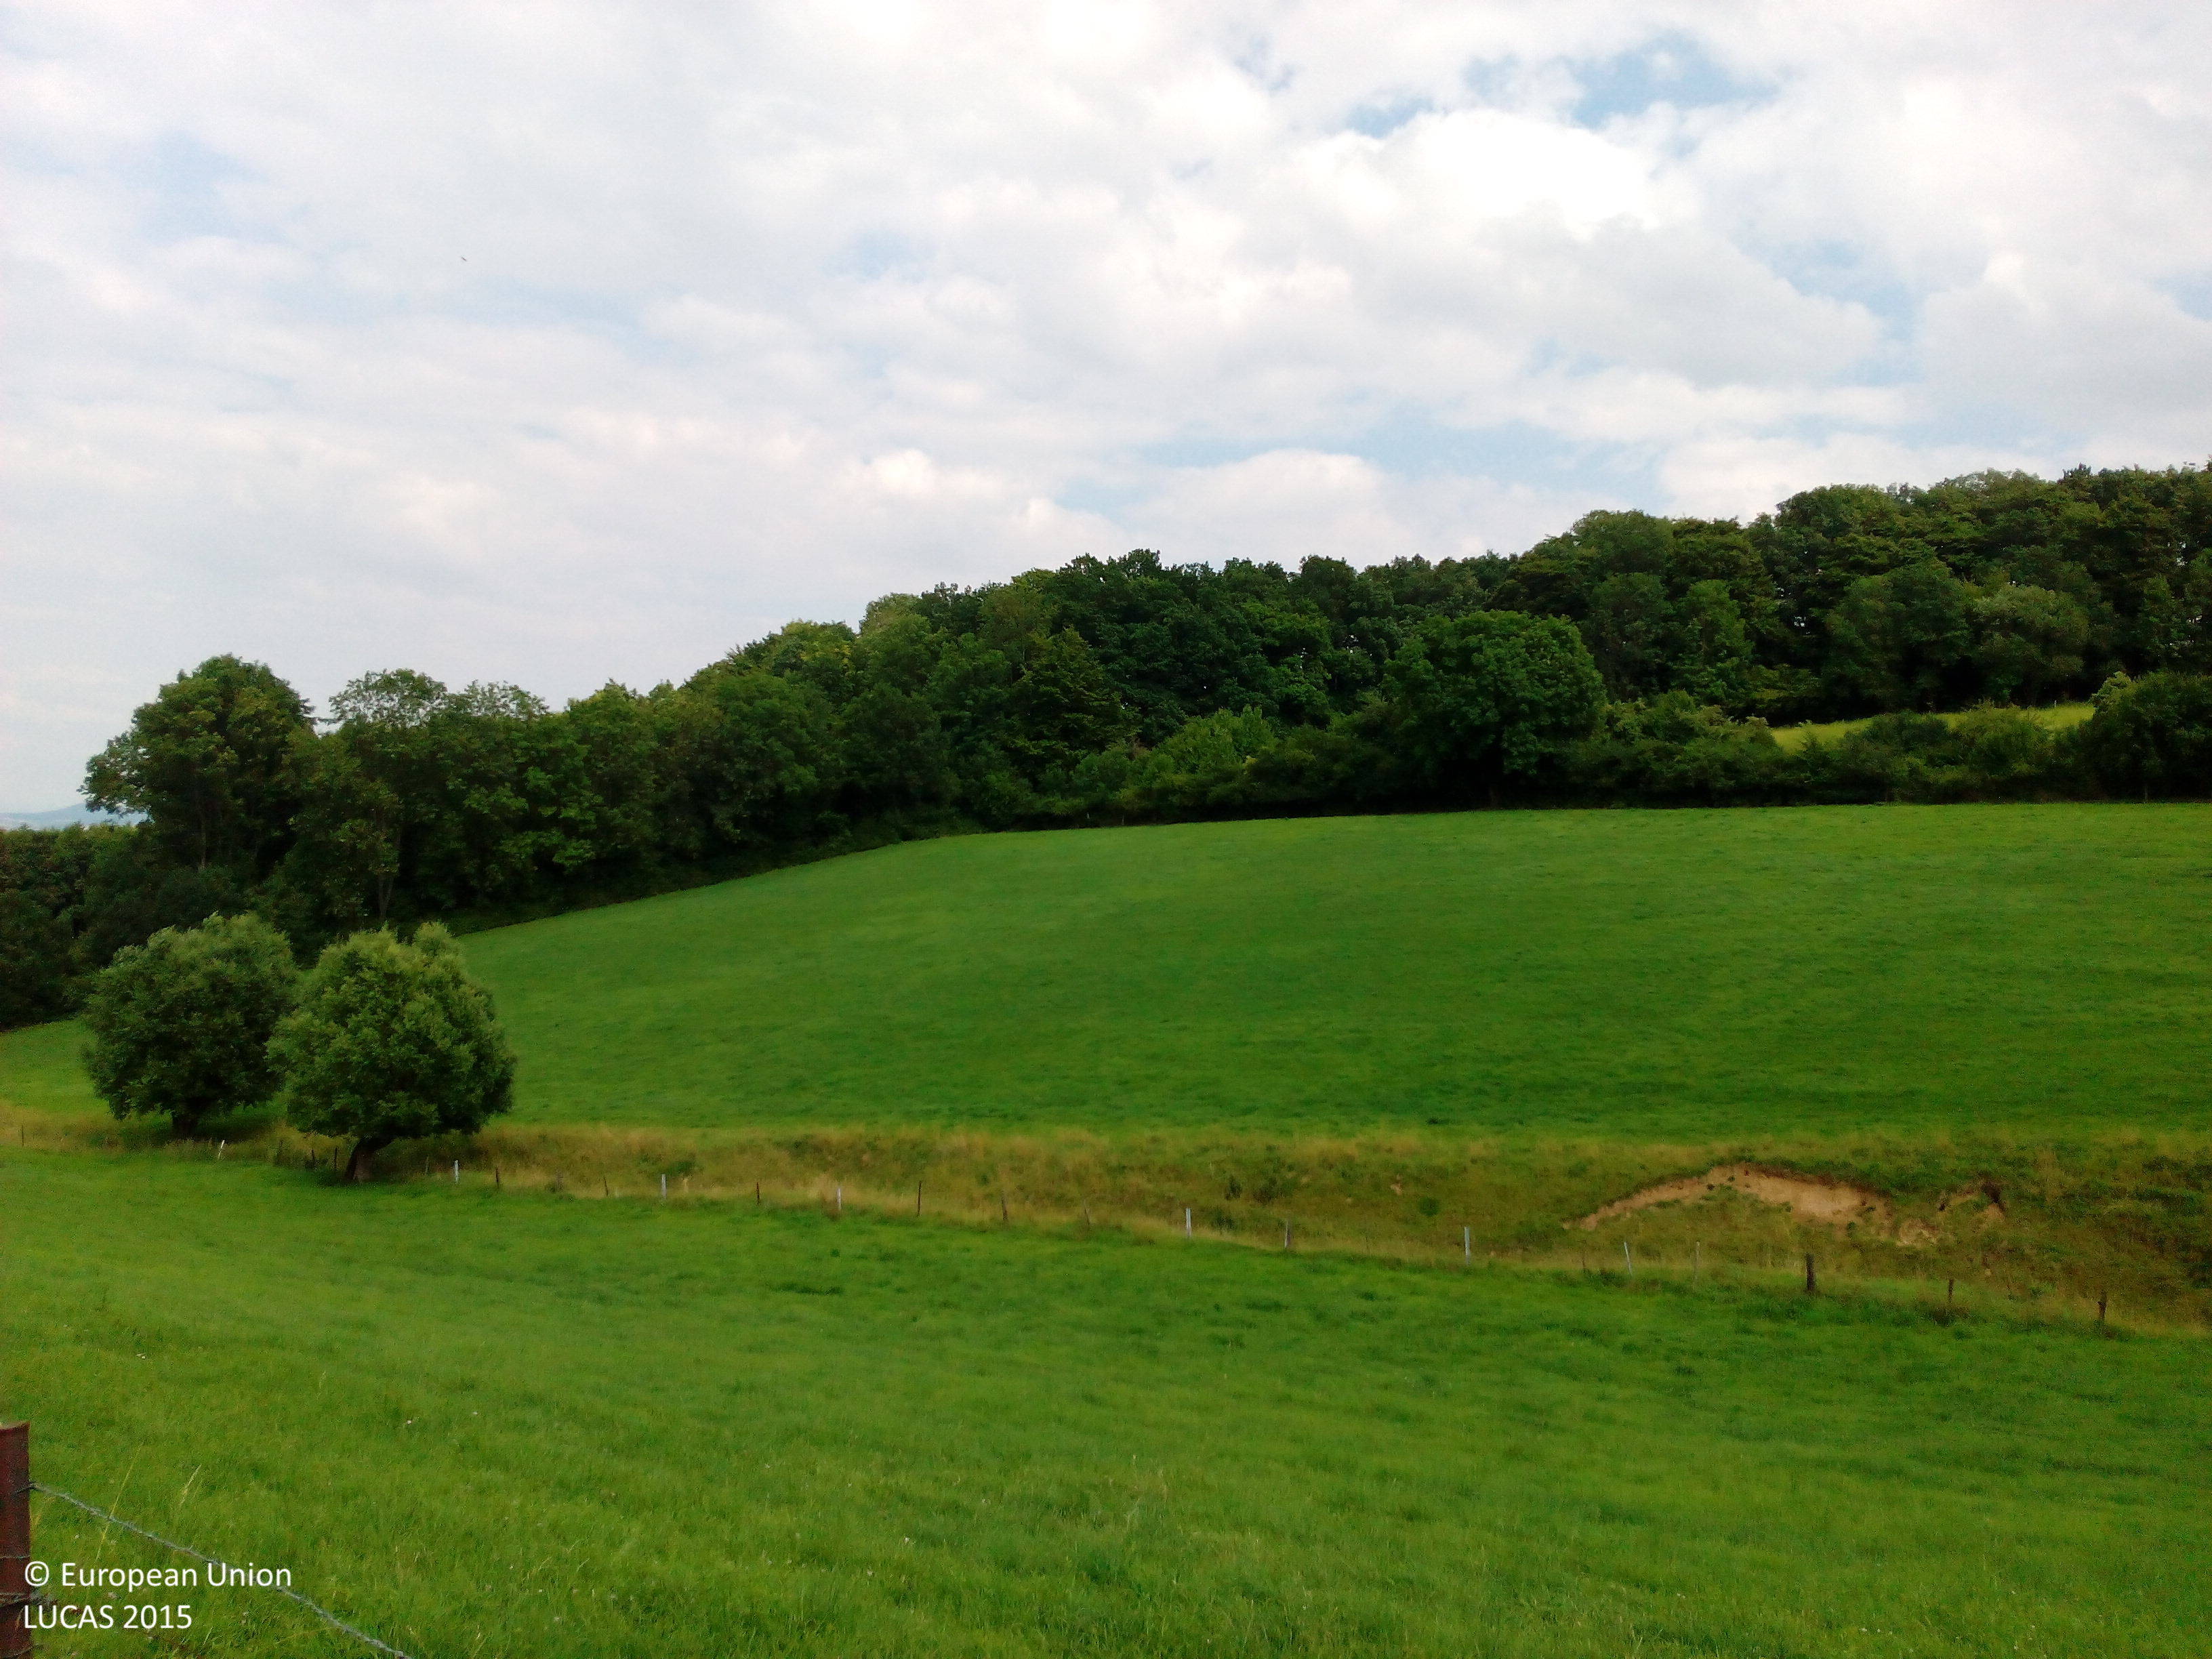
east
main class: Grassland
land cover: Grassland without tree/shrub cover
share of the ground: > 75 %
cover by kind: herbaceous plants 100 %
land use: Agriculture (excluding fallow land and kitchen gardens)
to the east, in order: Grassland without tree/shrub cover; Broadleaved woodland; Tracks; Broadleaved woodland; Fences; Grassland without tree/shrub cover; Lines of trees; Grassland without tree/shrub cover
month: July
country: DE
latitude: 51.4247
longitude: 9.8706
